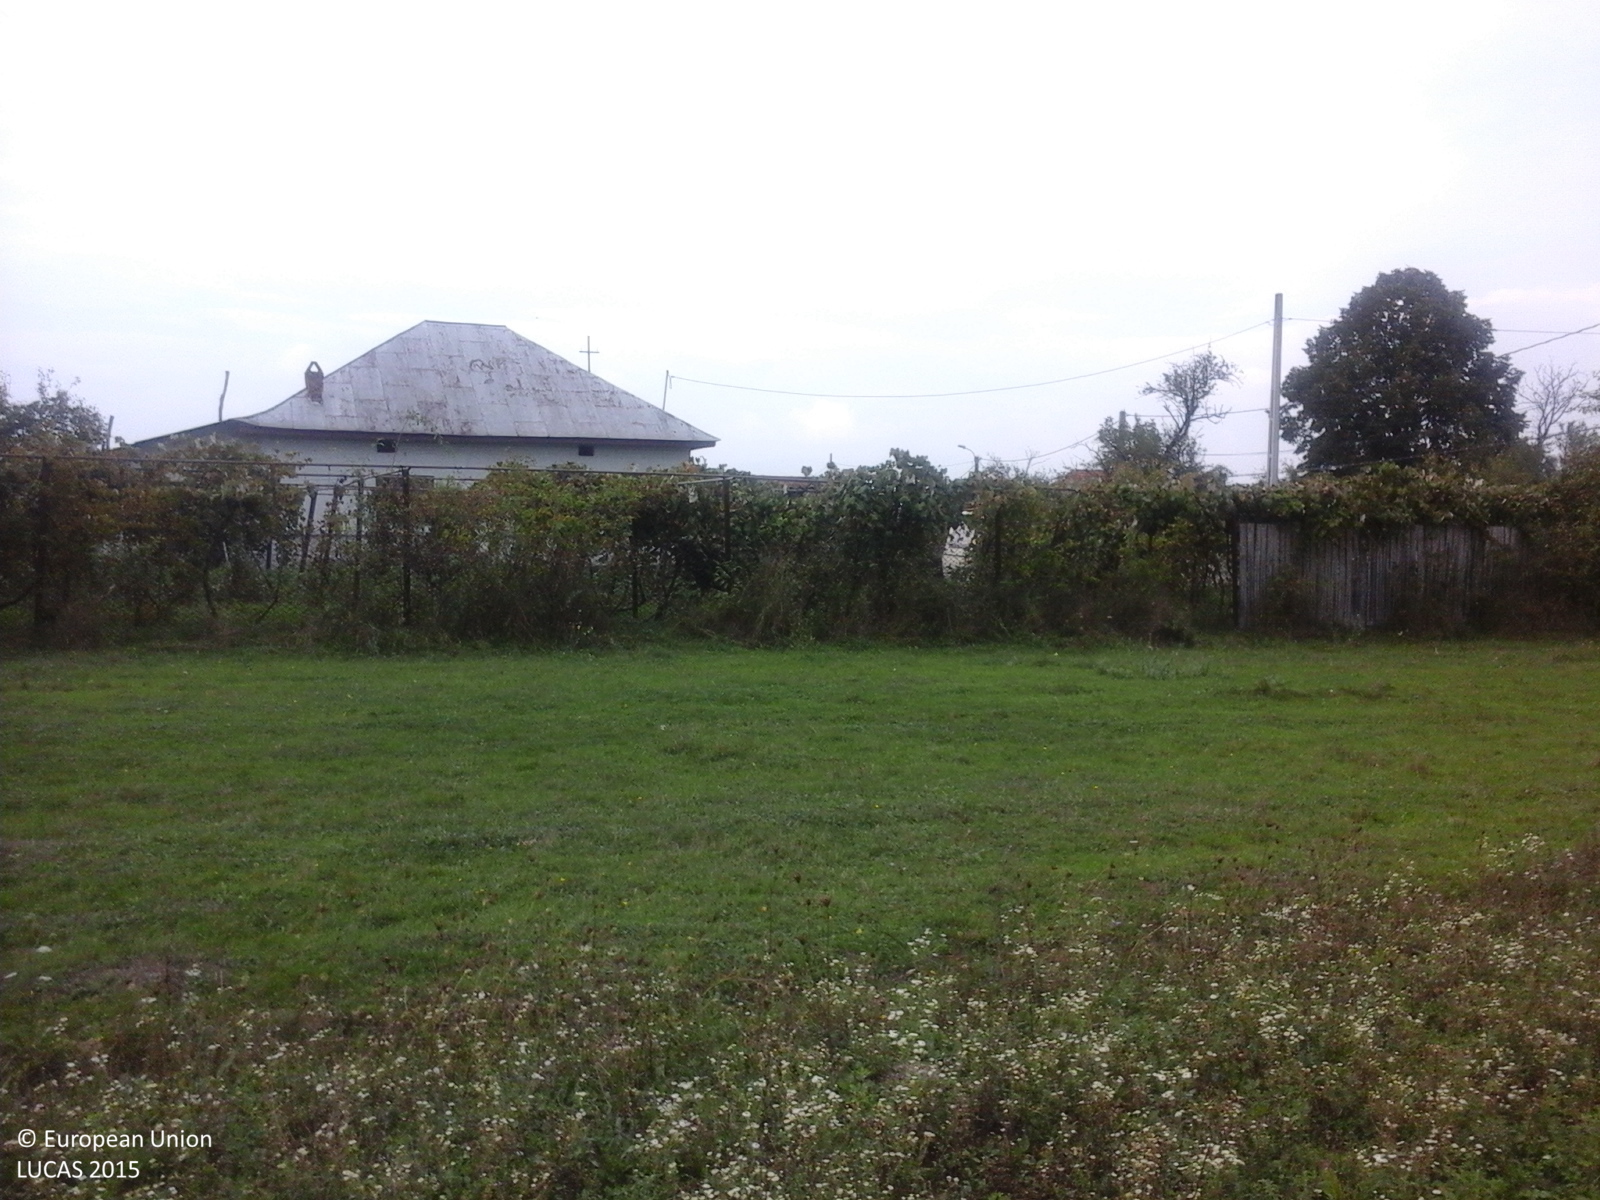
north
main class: Cropland
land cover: Lucerne
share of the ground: > 75 %
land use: Agriculture (excluding fallow land and kitchen gardens)
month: September
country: RO
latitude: 45.0438
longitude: 23.1409
